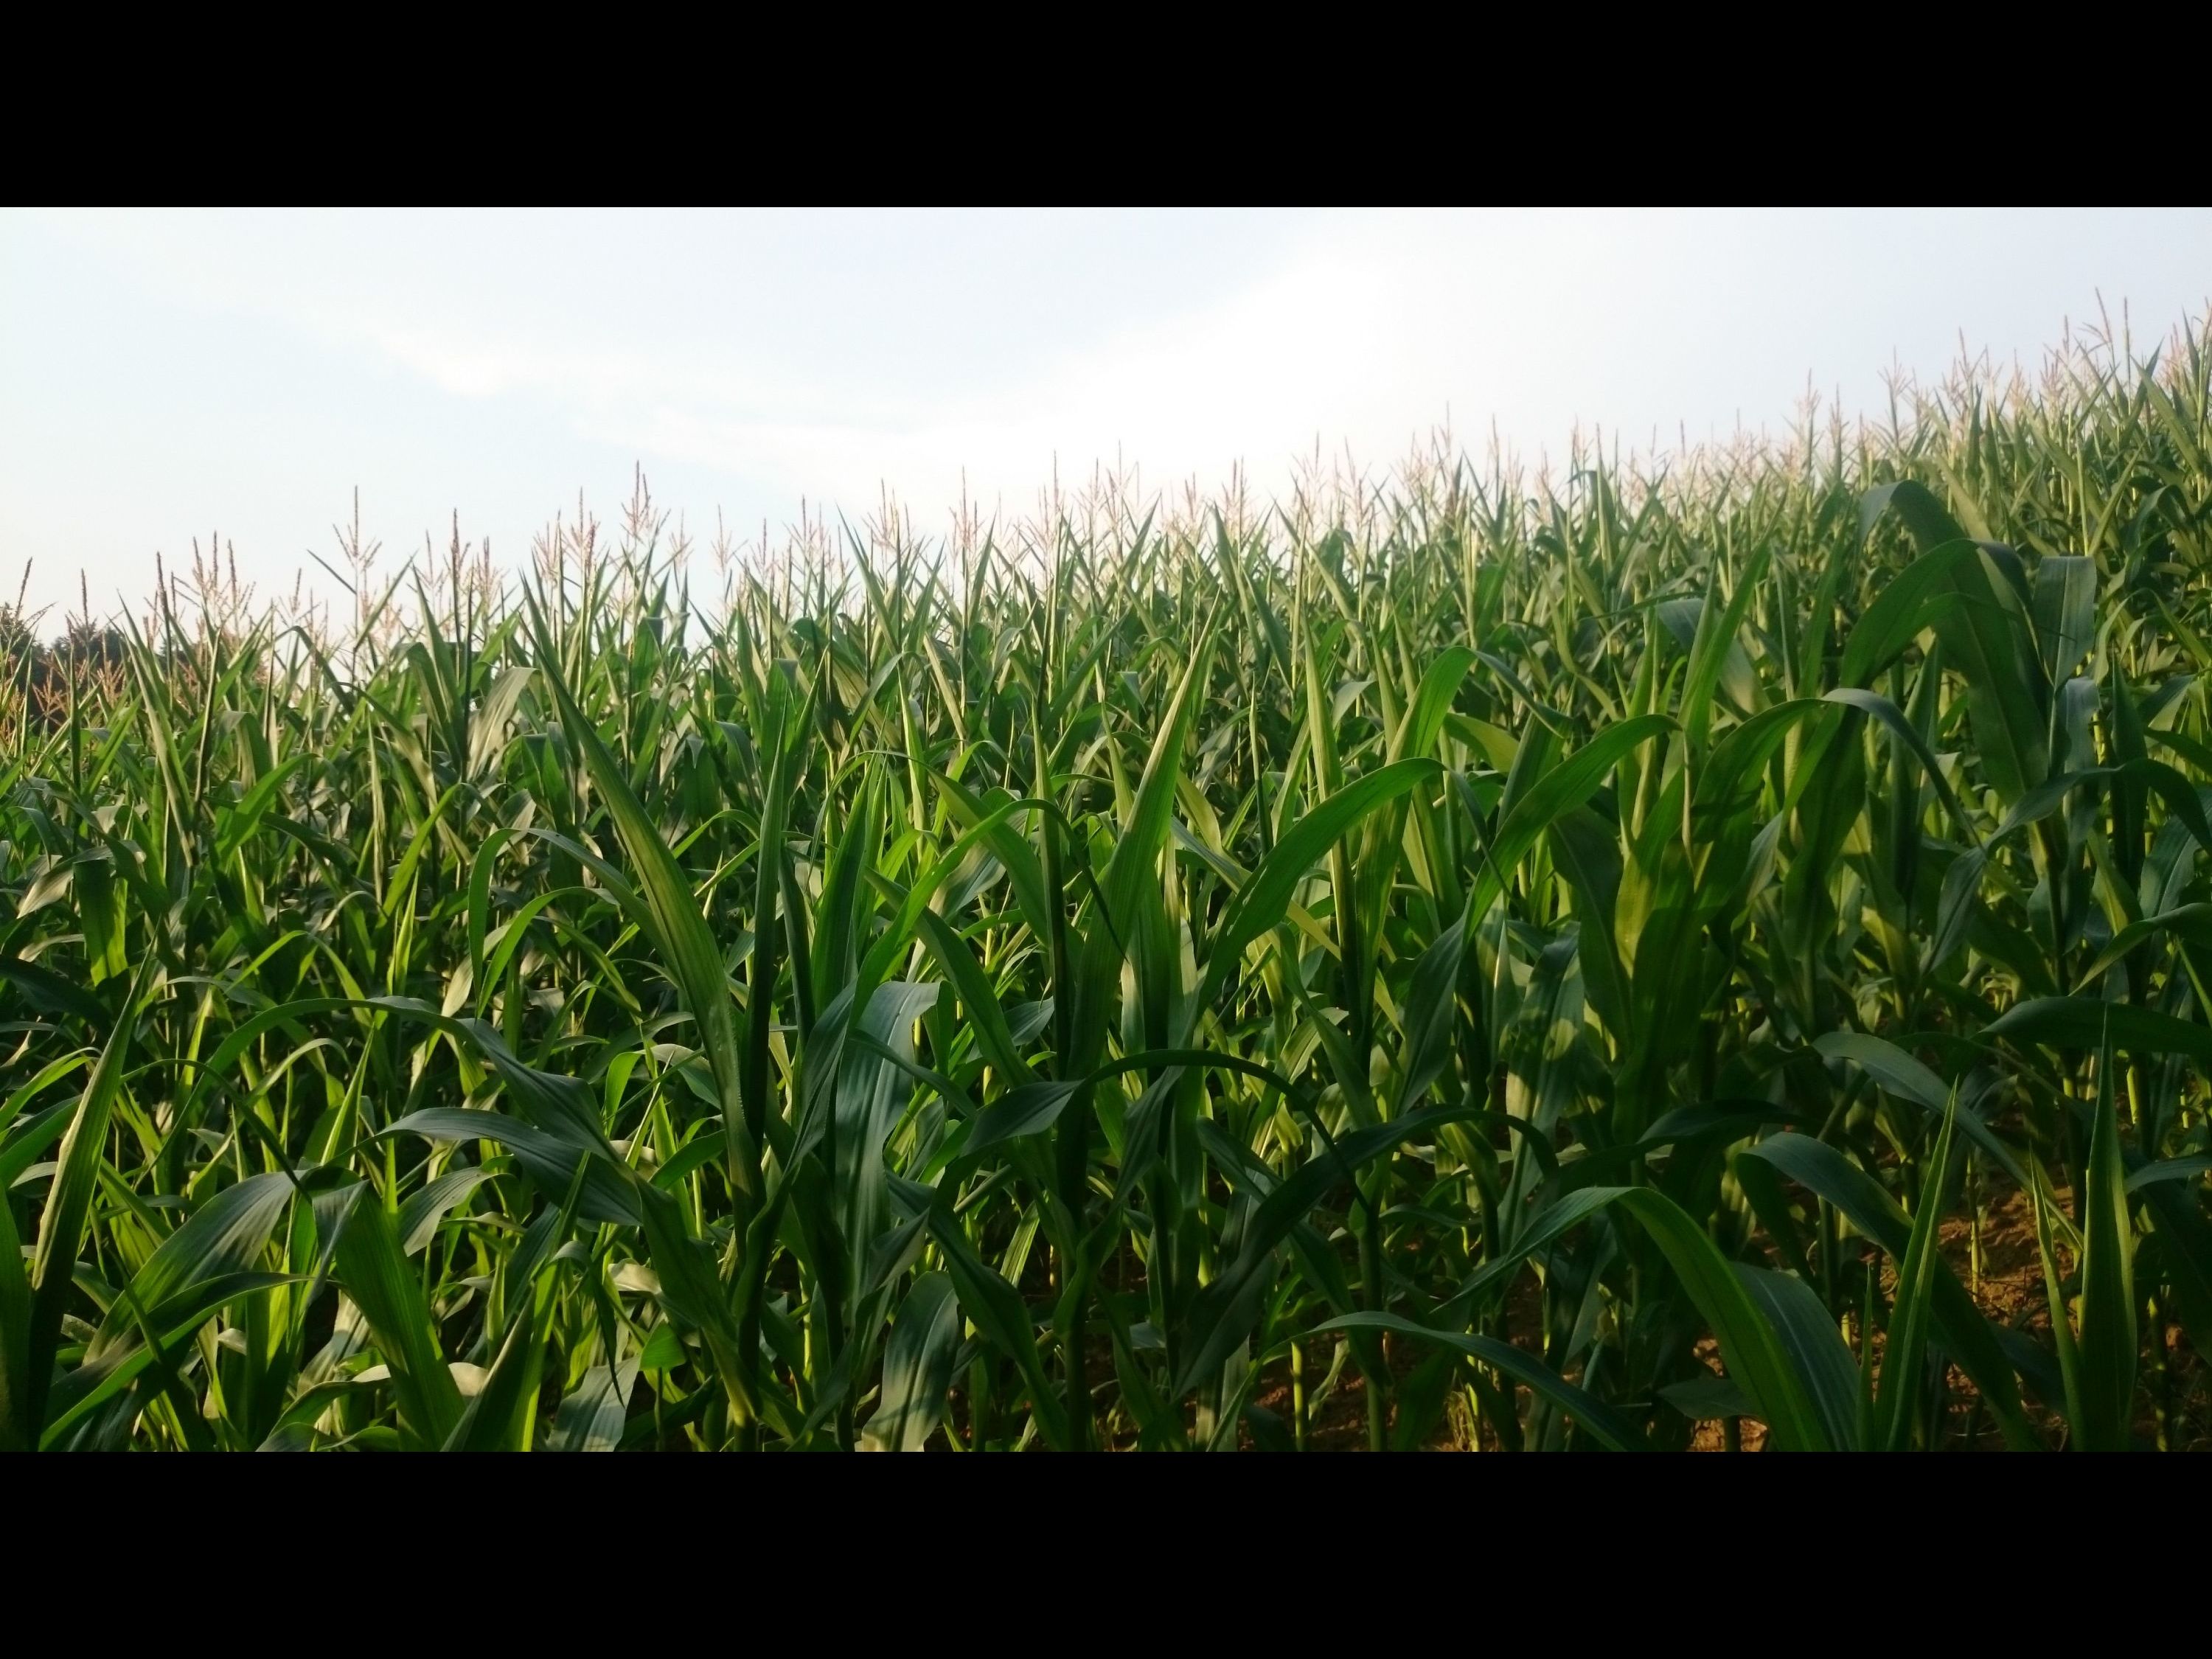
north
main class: Cropland
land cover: Maize
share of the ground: > 75 %
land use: Agriculture (excluding fallow land and kitchen gardens)
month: July
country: AT
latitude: 47.0708
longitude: 15.9400
